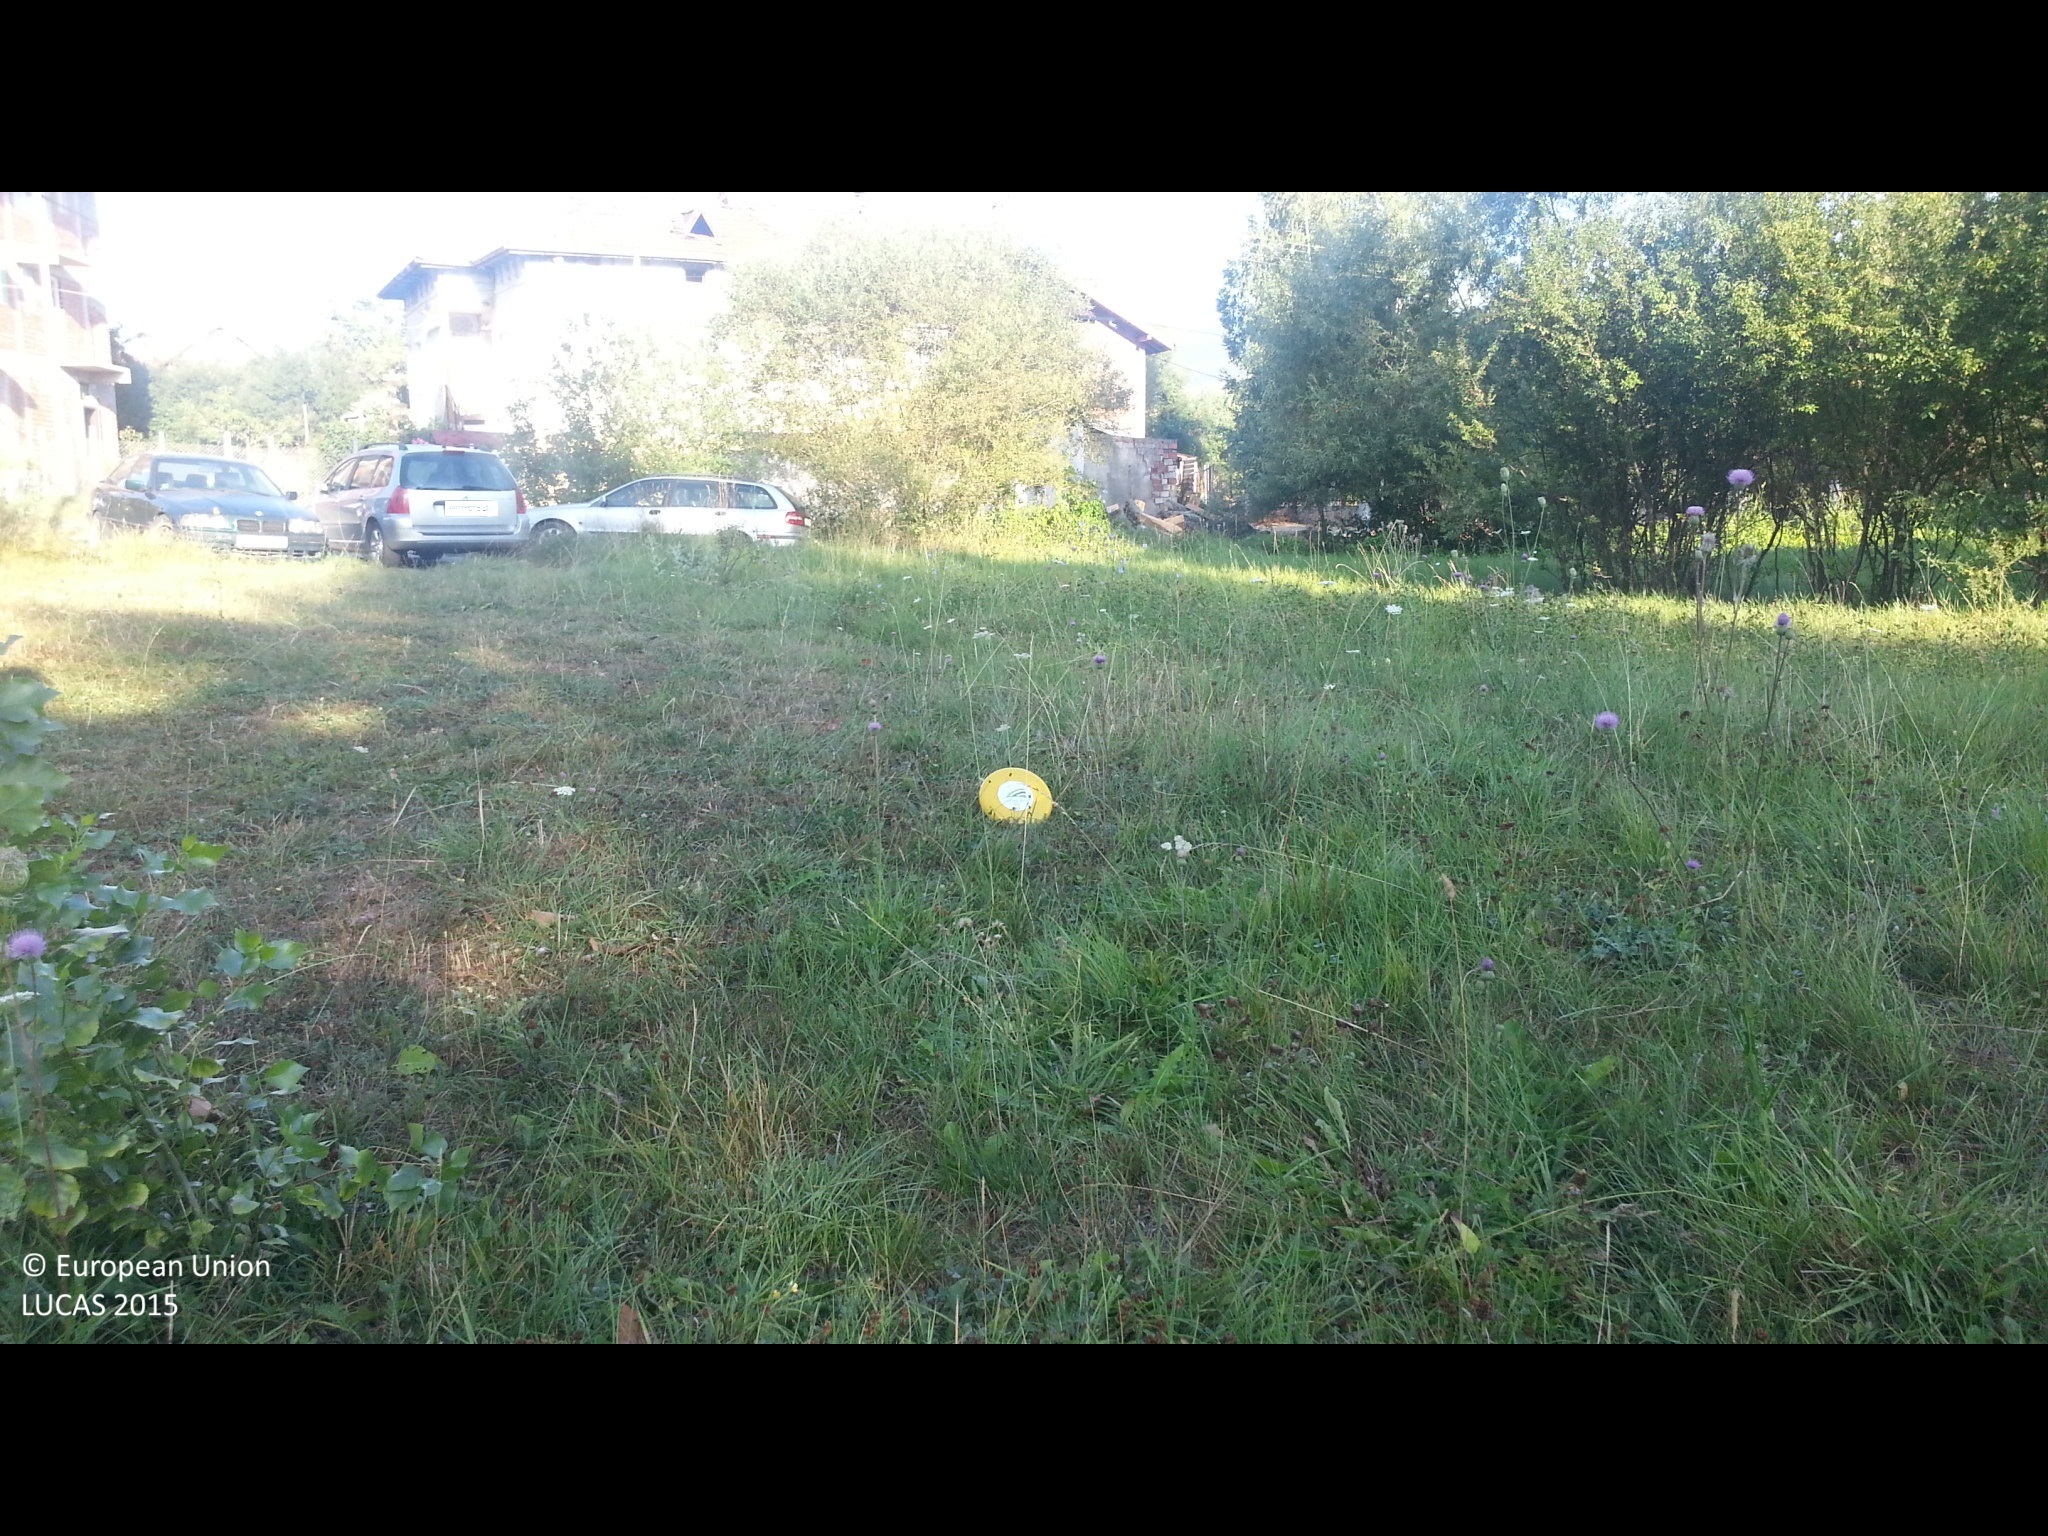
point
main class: Grassland
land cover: Grassland without tree/shrub cover
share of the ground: > 75 %
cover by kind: herbaceous plants 100 %
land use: Abandoned areas
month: August
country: BG
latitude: 42.2751
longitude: 22.6679
